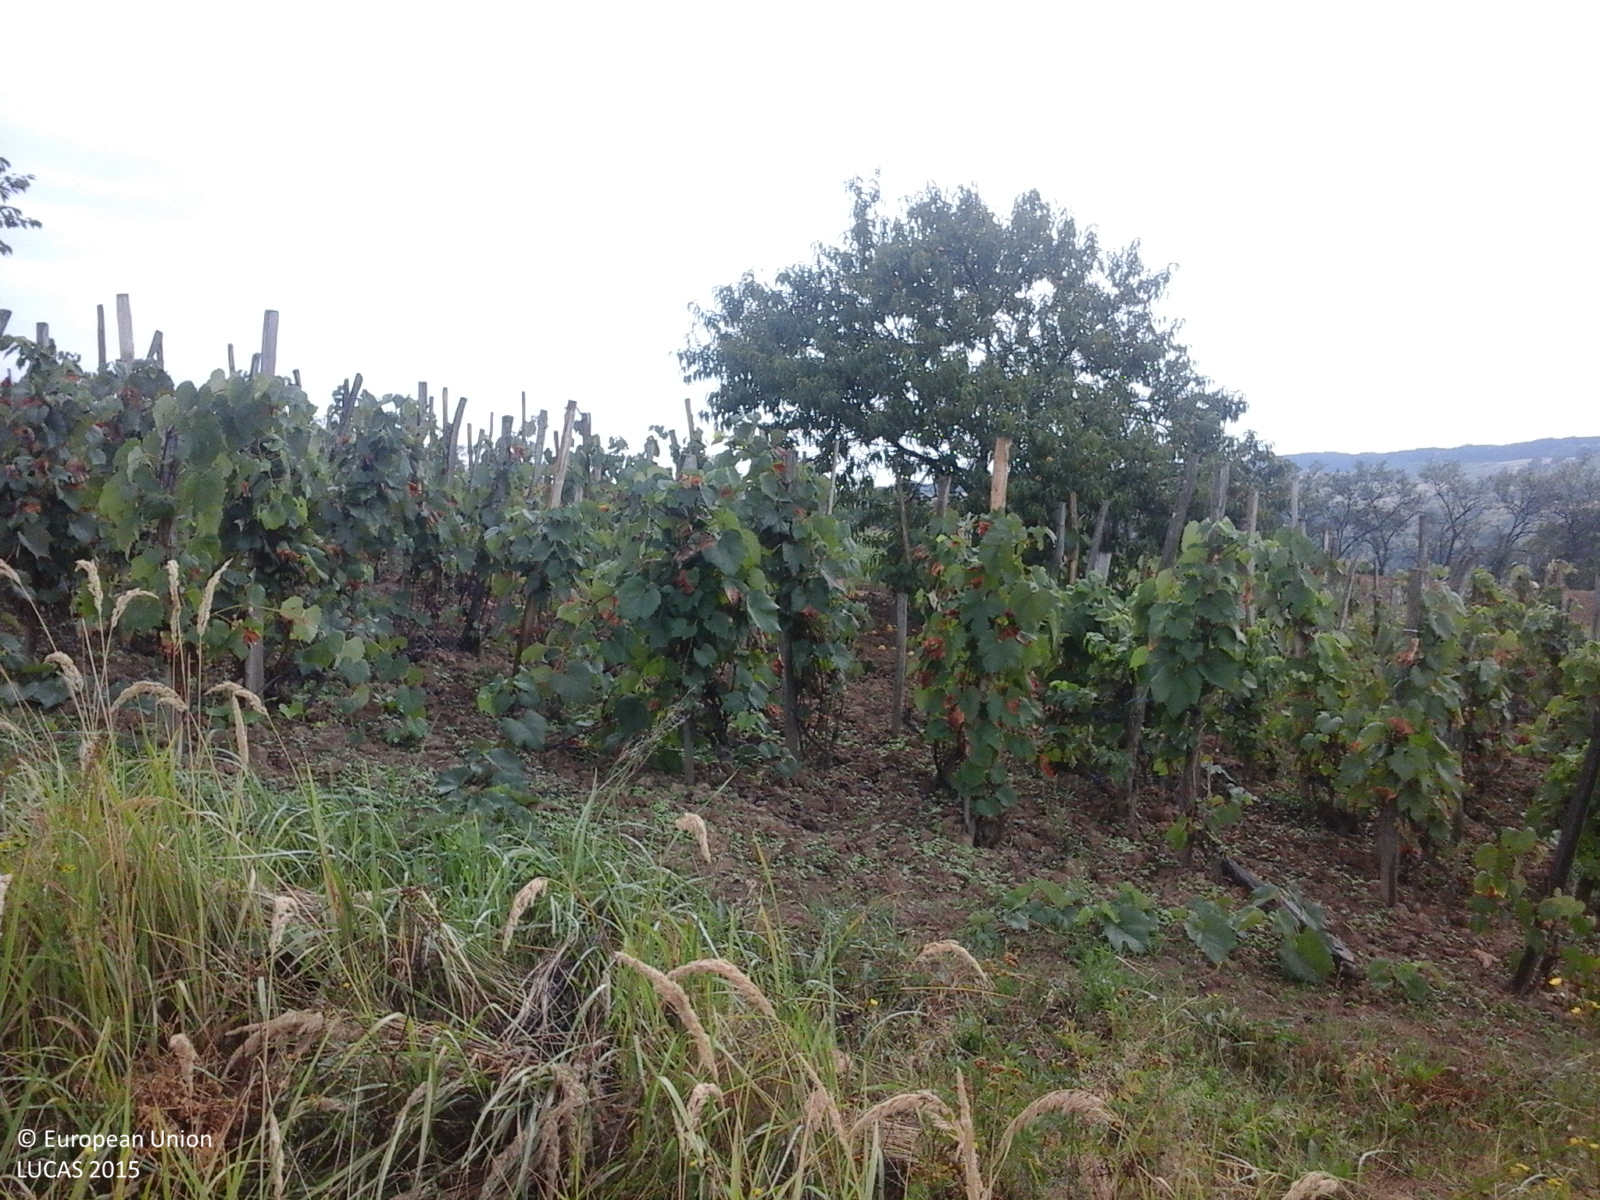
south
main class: Grassland
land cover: Grassland with sparse tree/shrub cover
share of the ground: > 75 %
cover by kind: herbaceous plants 85 %, shrubs 10 %, broadleaved forest trees 5 %
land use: Fallow land
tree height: < 5 m
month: September
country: RO
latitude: 47.3698
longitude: 22.5986
